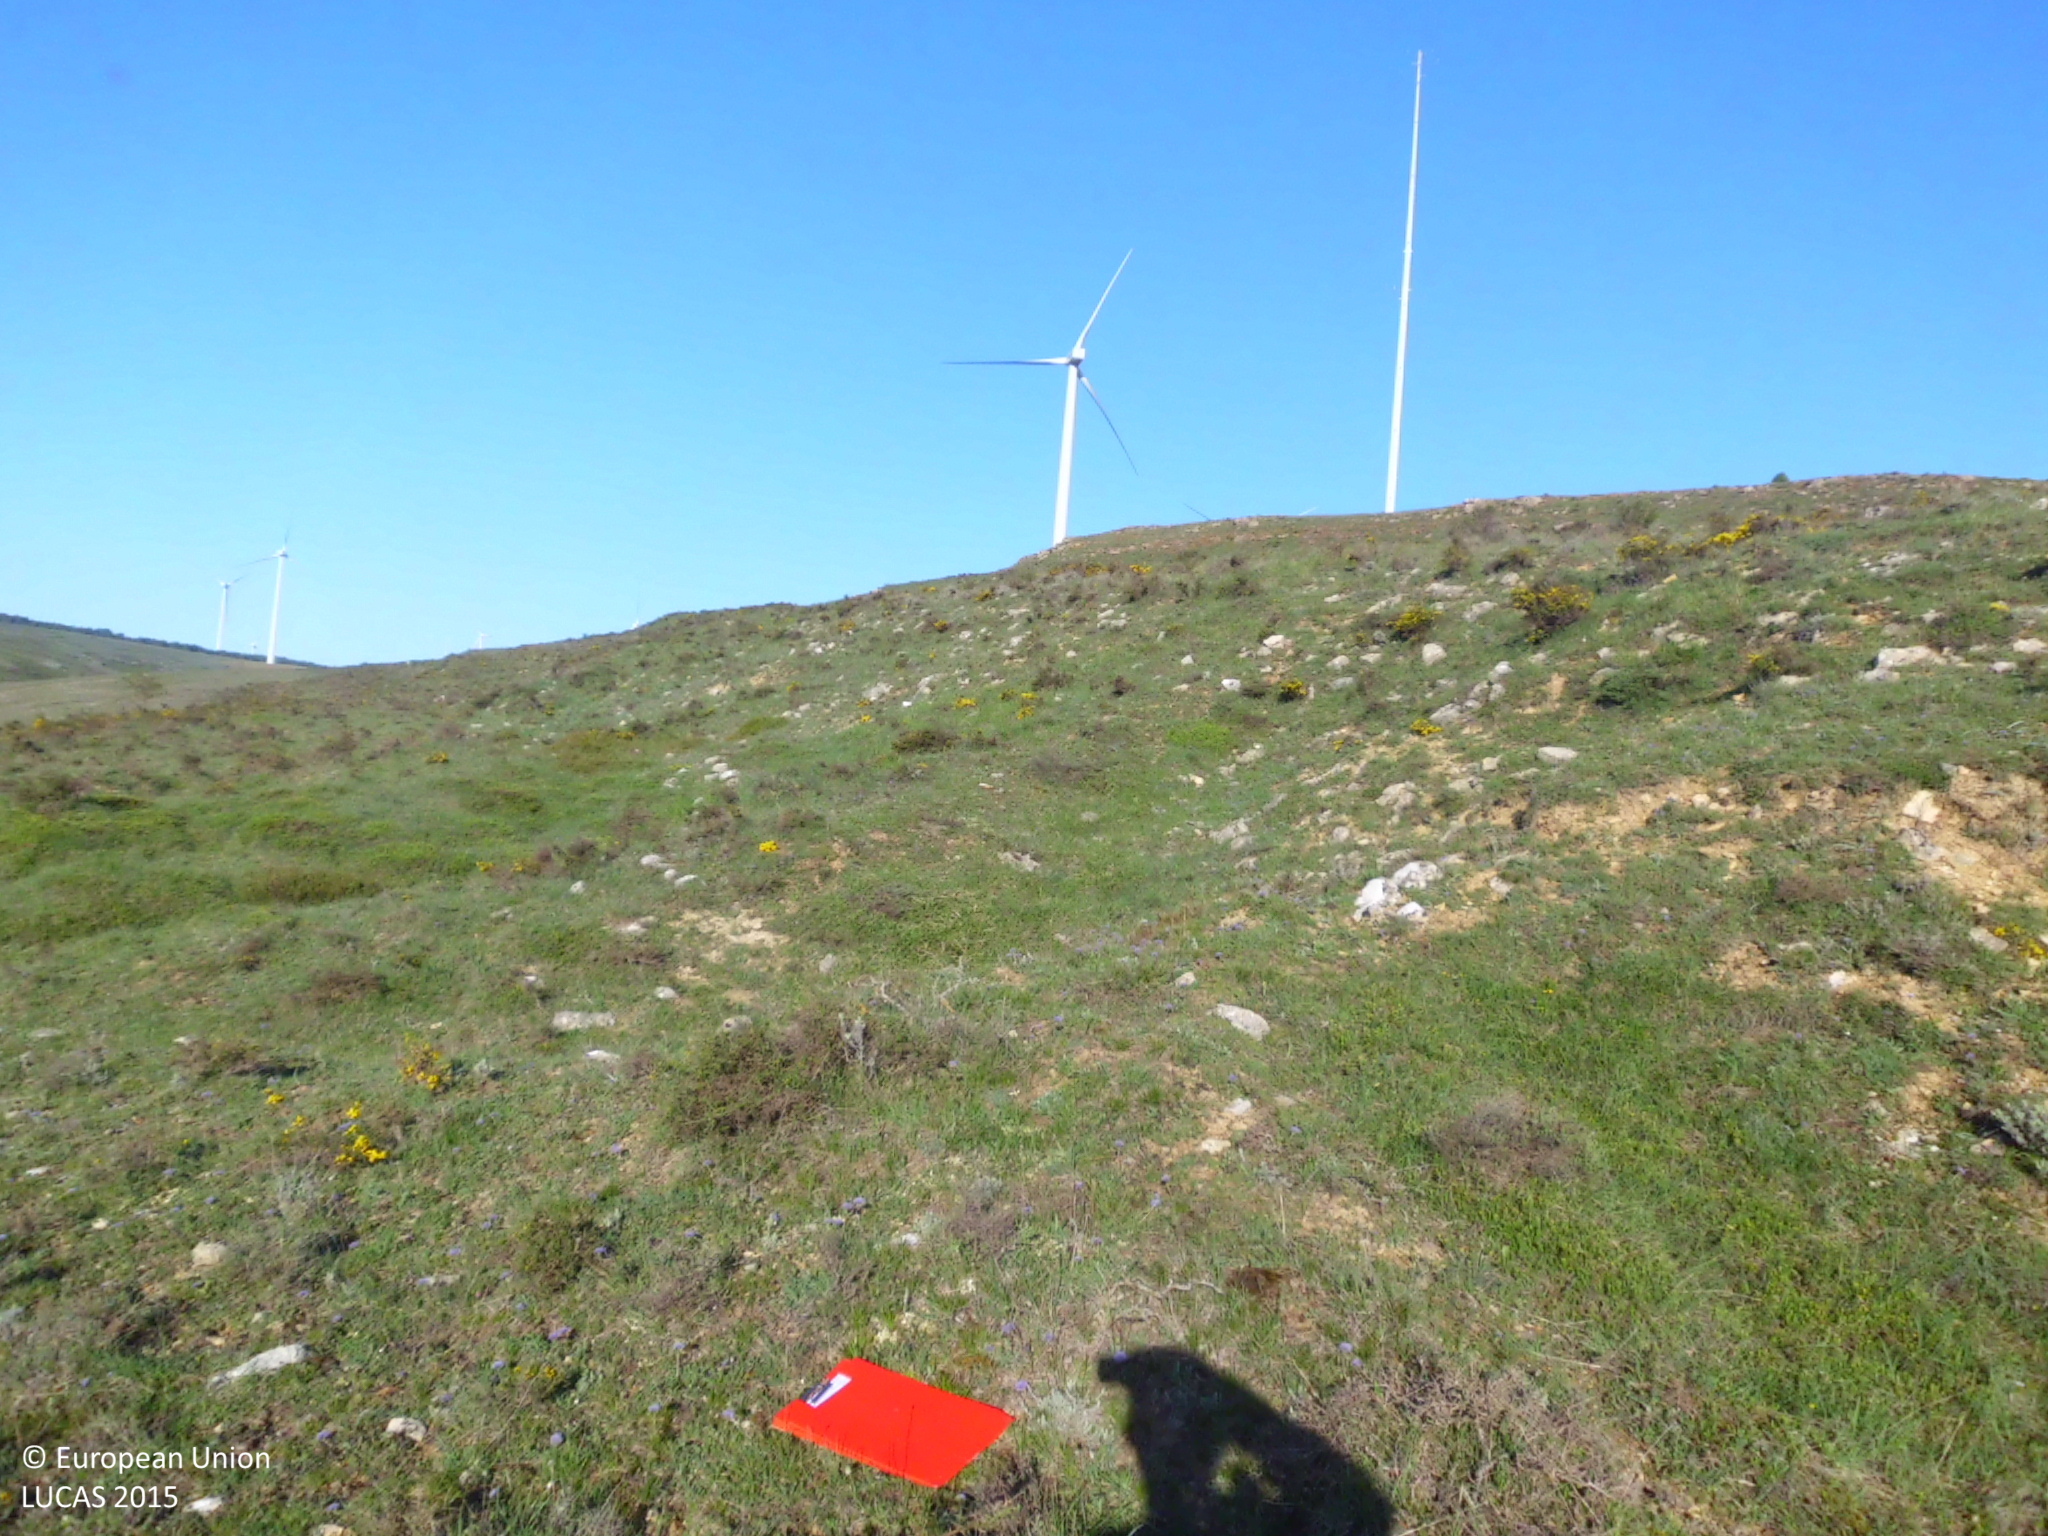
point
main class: Shrubland
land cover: Shrubland without tree cover
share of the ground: 50 - 75 %
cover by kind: shrubs 60 %, herbaceous plants 40 %
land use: Abandoned areas
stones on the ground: 25 - 50 %
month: May
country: ES
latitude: 42.6813
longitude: -3.7454
